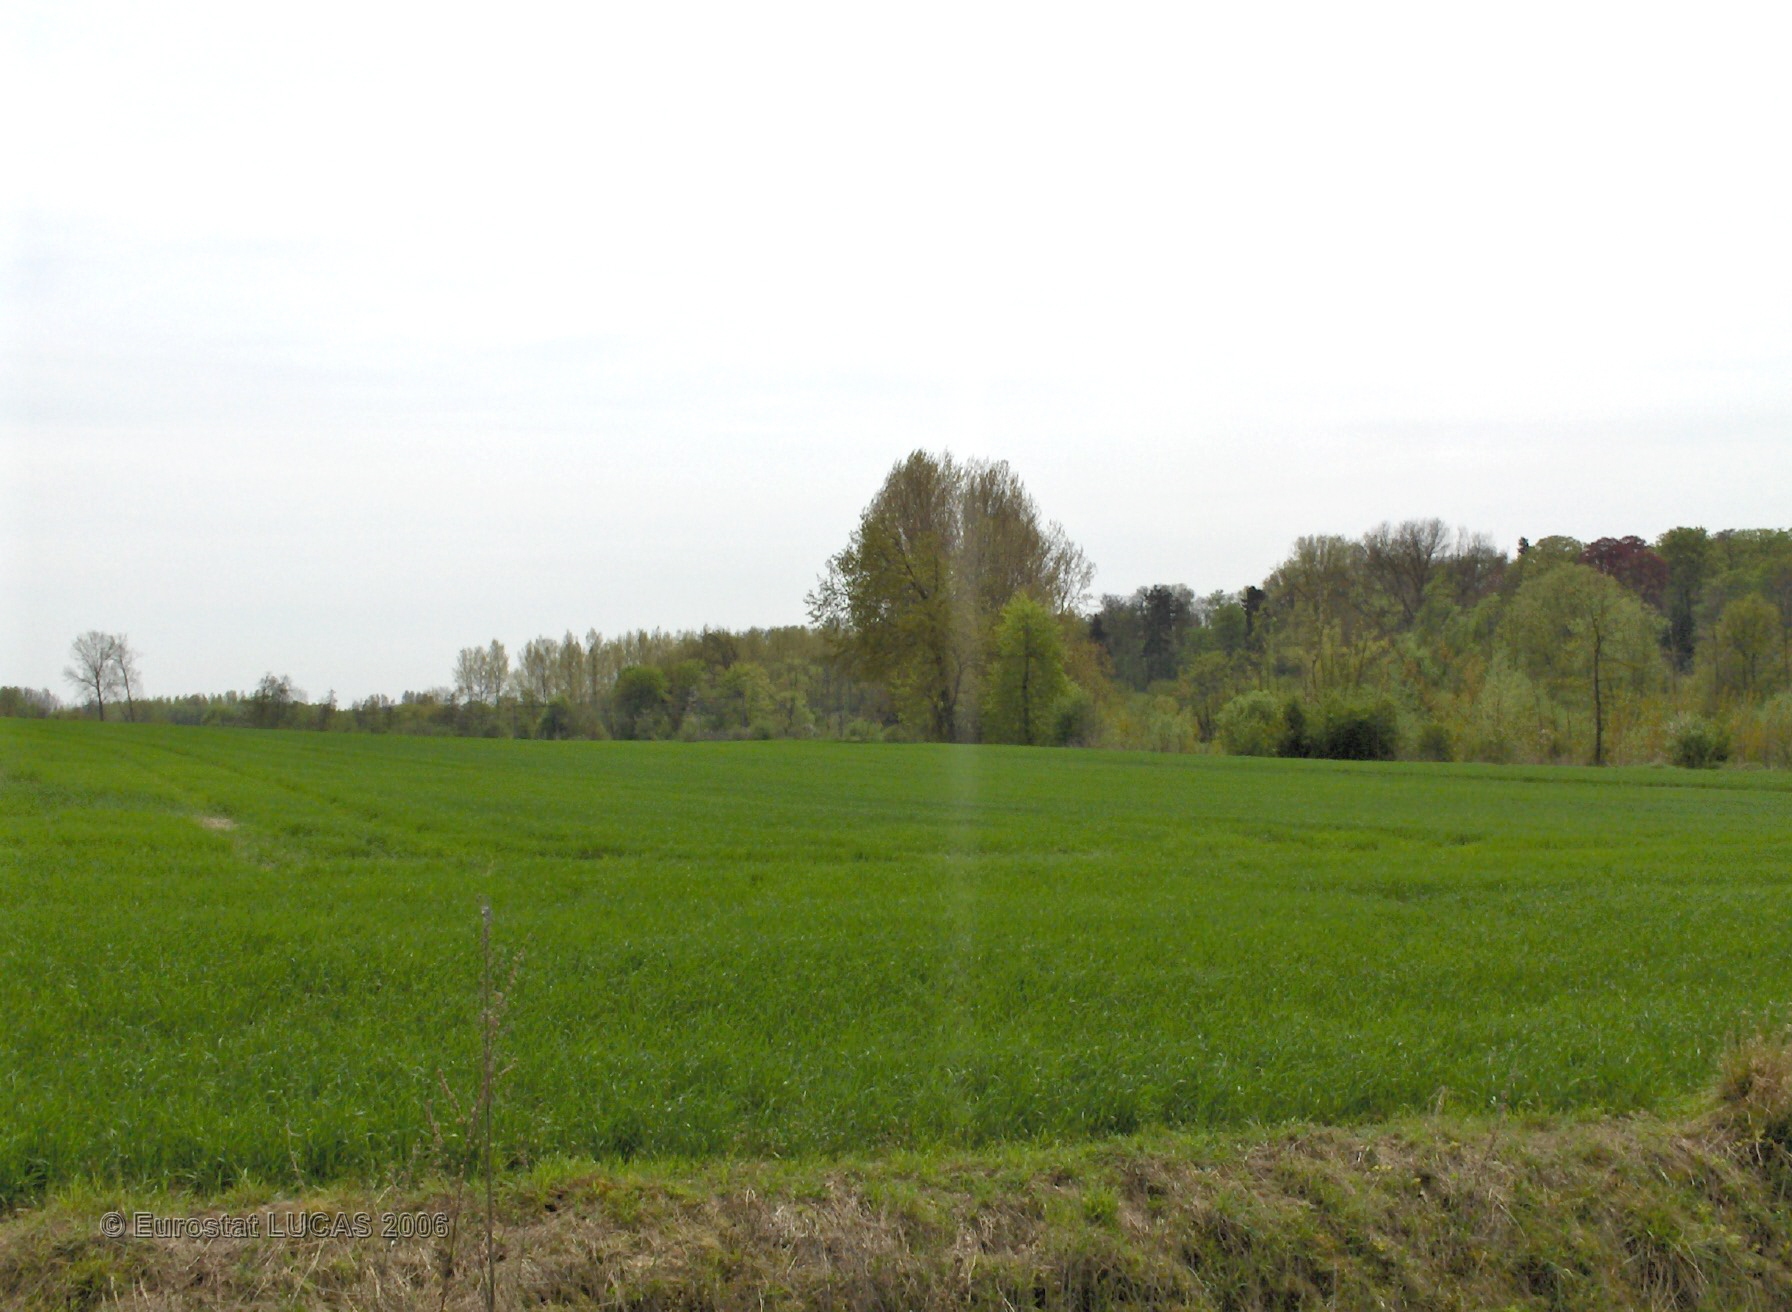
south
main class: Grassland
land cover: Grassland without tree/shrub cover
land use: Agriculture (excluding fallow land and kitchen gardens)
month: May
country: BE
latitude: 50.7135
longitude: 5.1965
